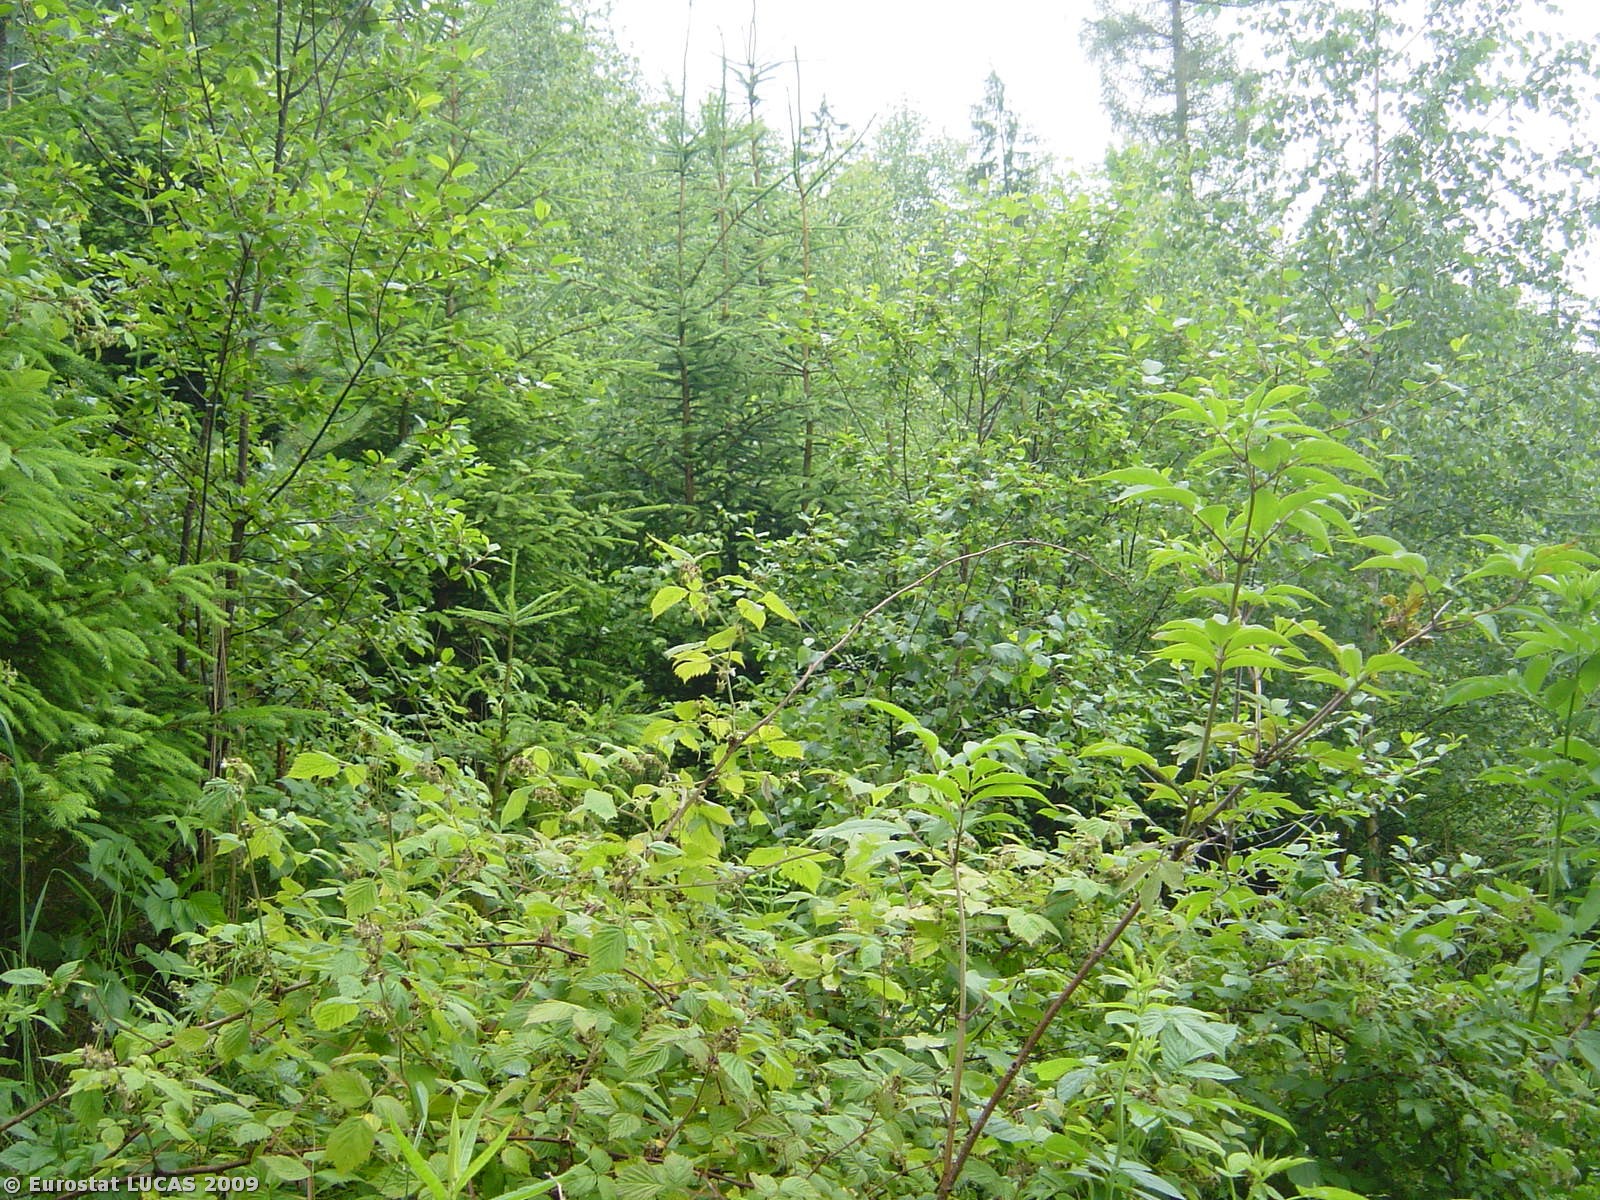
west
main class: Woodland
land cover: Mixed woodland
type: hemiboreal forest and nemoral coniferous forest and mixed broadleaved-coniferous forest
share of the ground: > 75 %
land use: Forestry
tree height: > 5 m
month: June
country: CZ
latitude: 49.6557
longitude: 16.5040
